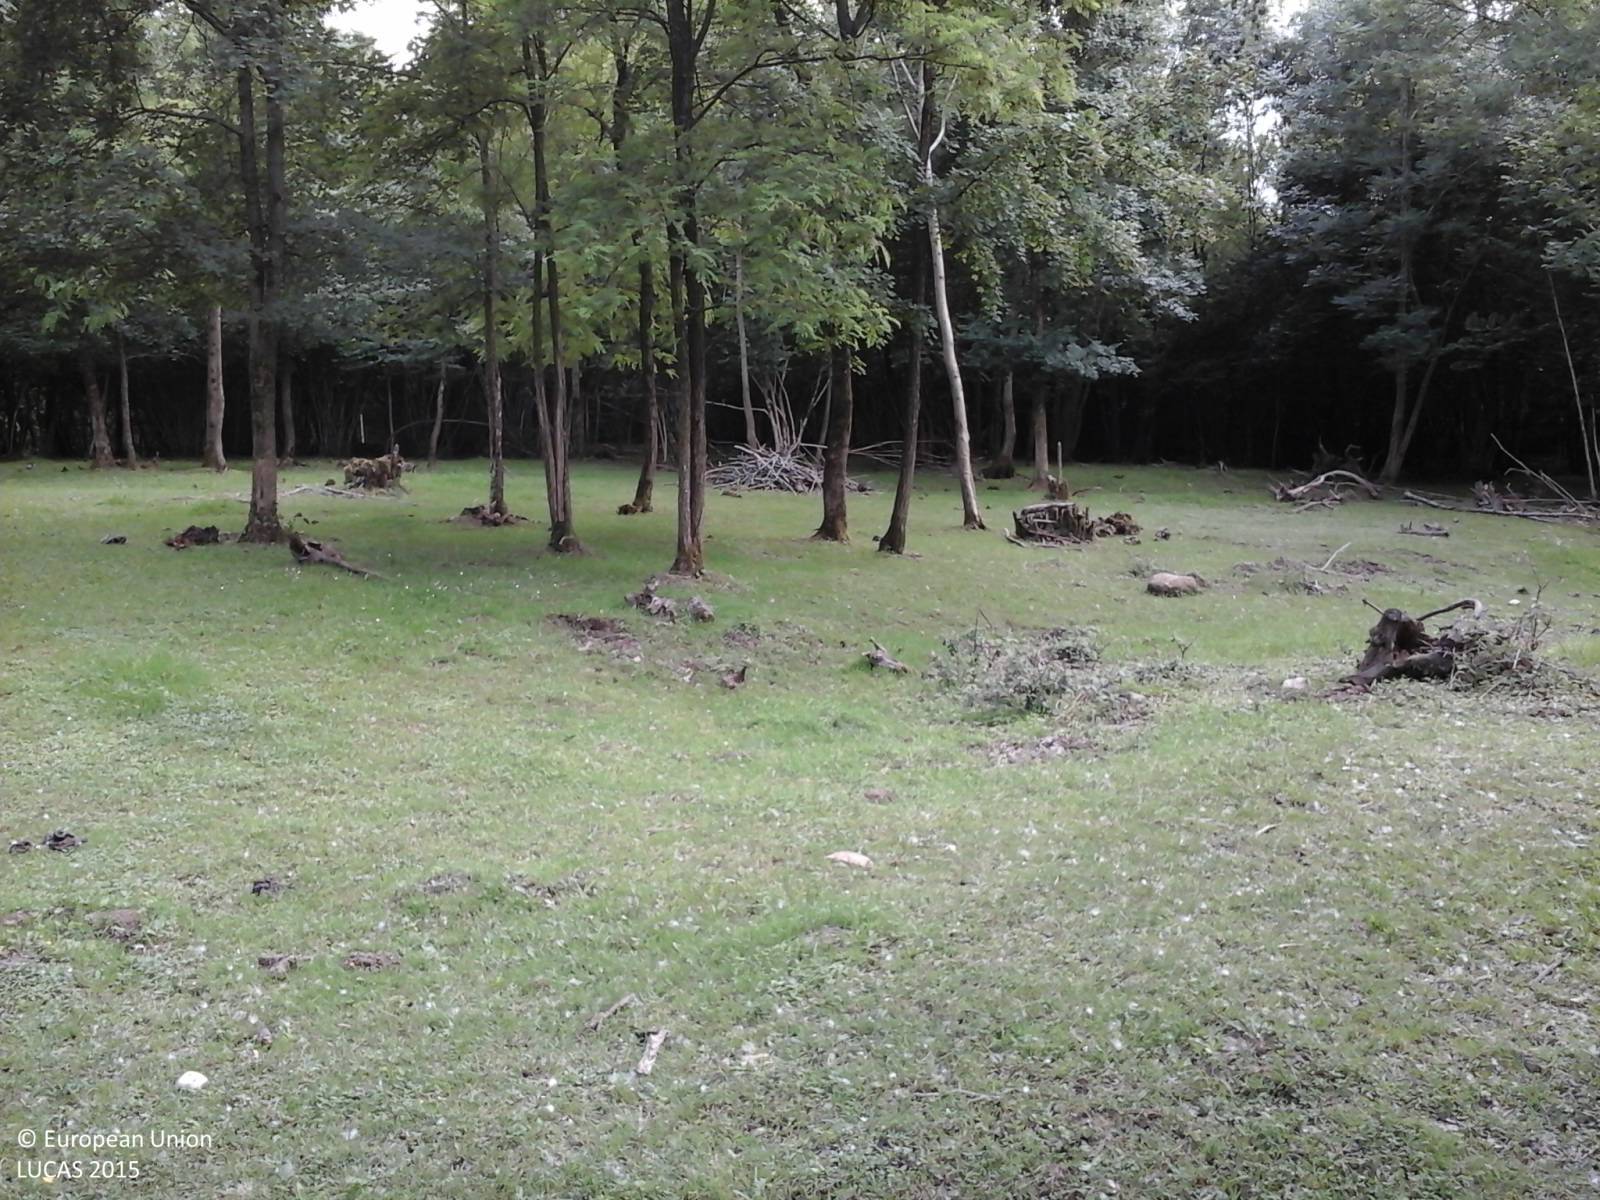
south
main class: Woodland
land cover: Broadleaved woodland
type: mesophytic deciduous forest
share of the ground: 50 - 75 %
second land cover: Grassland without tree/shrub cover
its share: > 75 %
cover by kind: broadleaved forest trees 60 %, herbaceous plants 40 %
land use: Forestry
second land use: Agriculture (excluding fallow land and kitchen gardens)
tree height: > 5 m
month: May
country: IT
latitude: 46.1561
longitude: 13.2985
